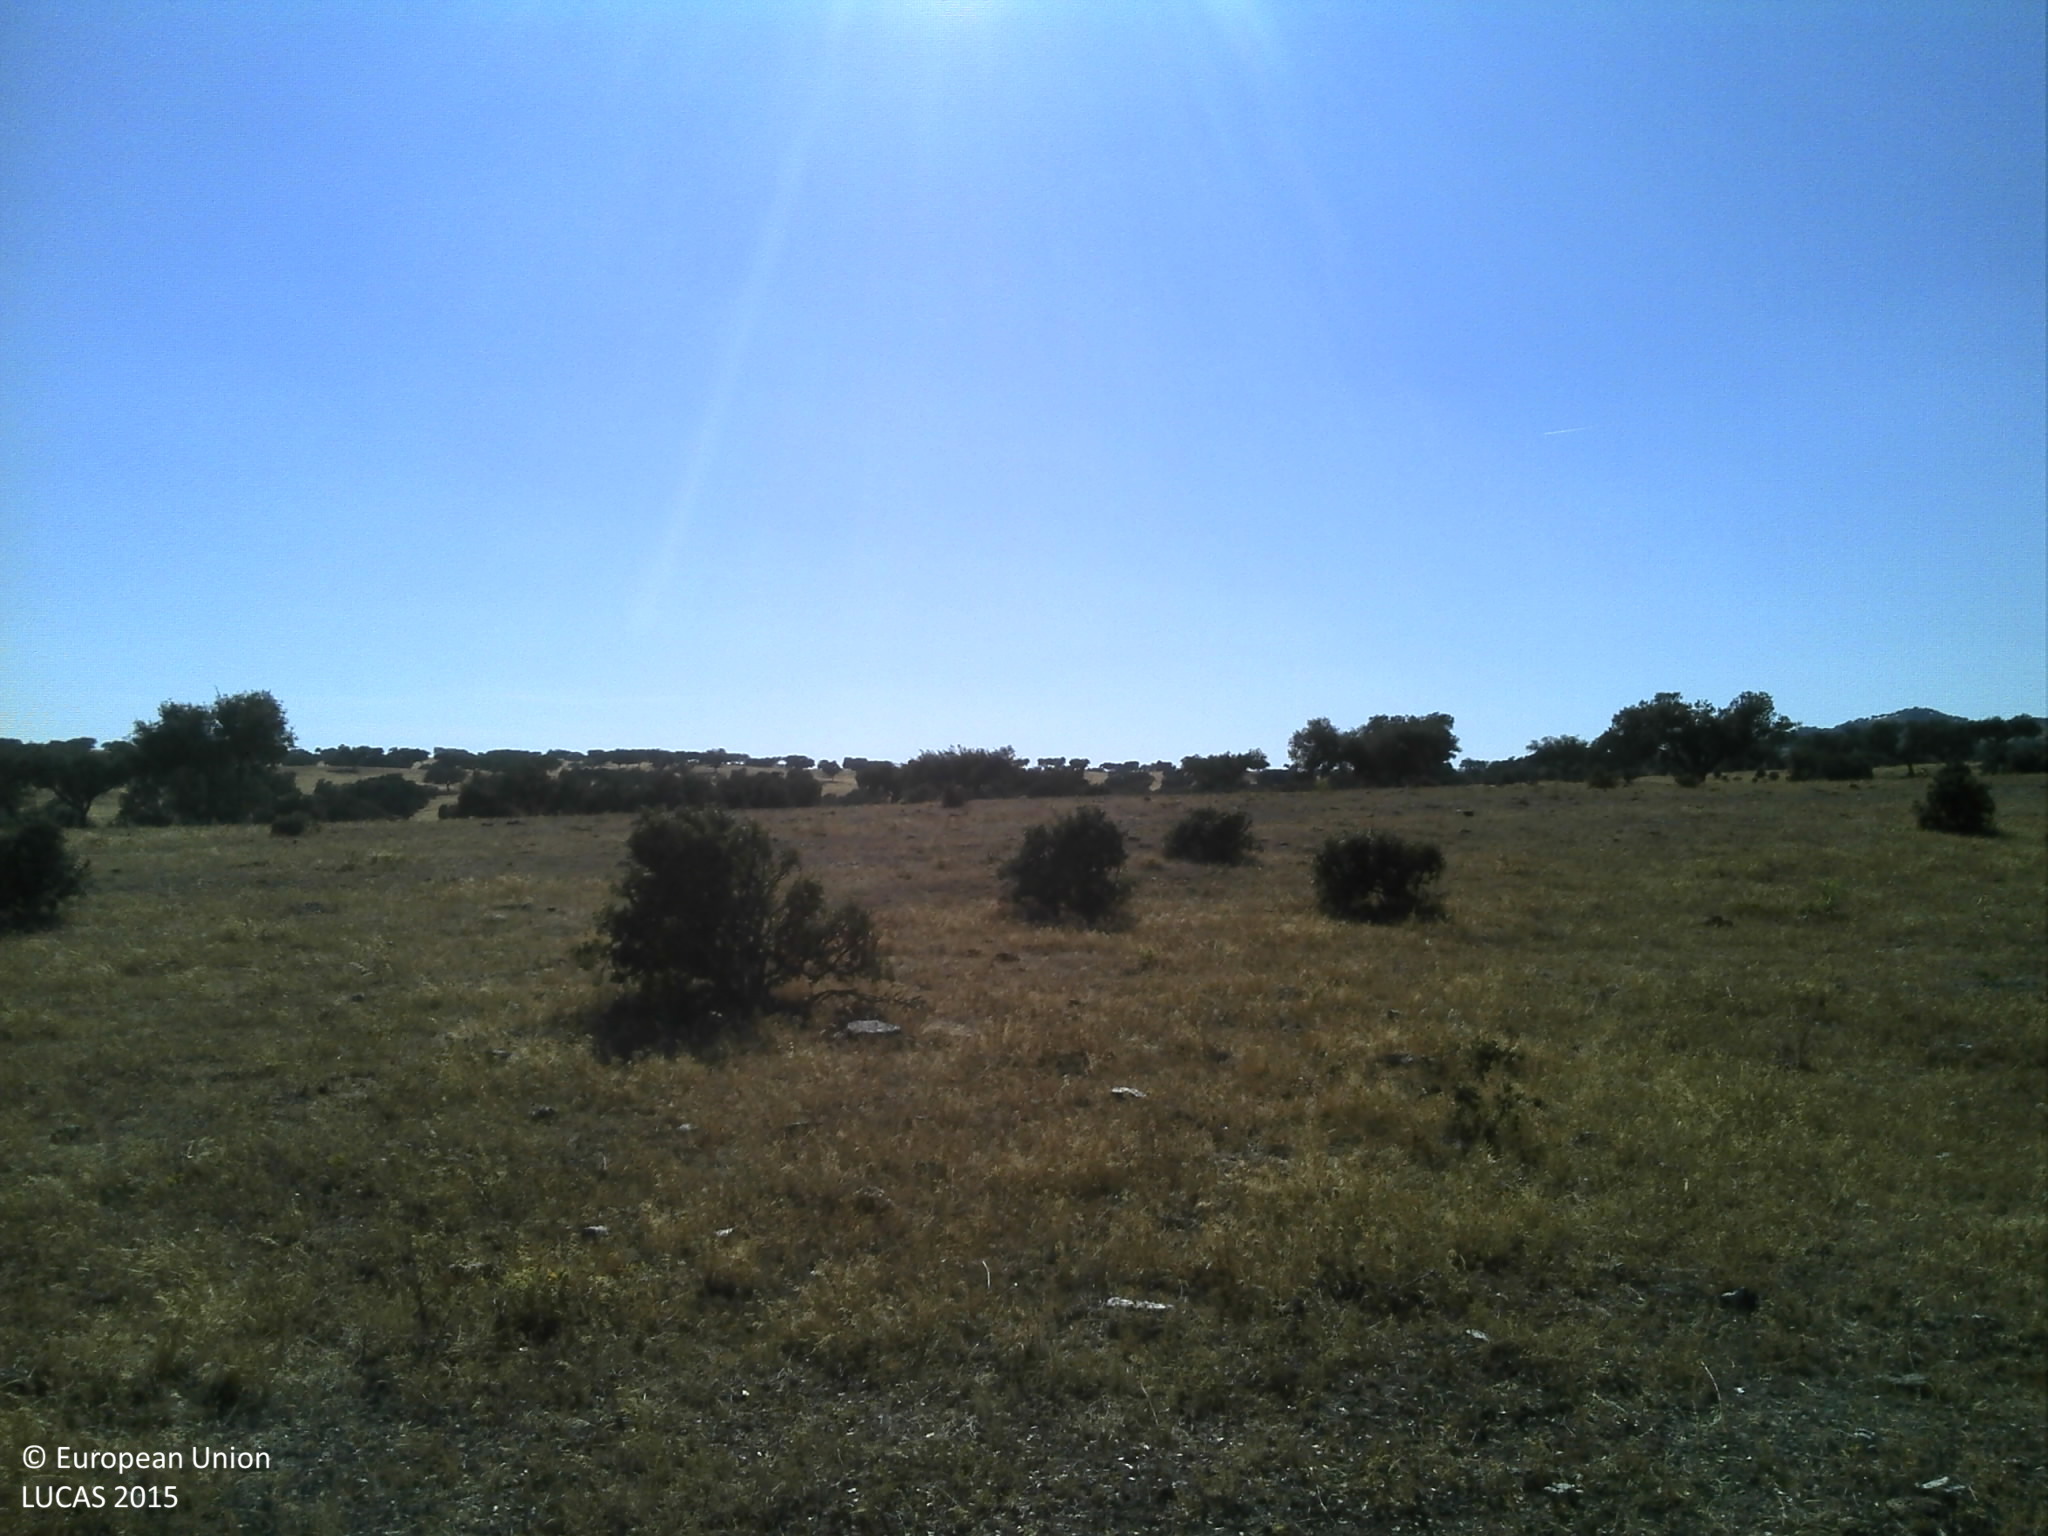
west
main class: Grassland
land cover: Grassland with sparse tree/shrub cover
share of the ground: 10 - 25 %
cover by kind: unconsolidated bare surface 70 %, herbaceous plants 25 %, broadleaved forest trees 5 %
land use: Agriculture (excluding fallow land and kitchen gardens)
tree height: < 5 m
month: July
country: PT
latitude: 38.5058
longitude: -7.4463
